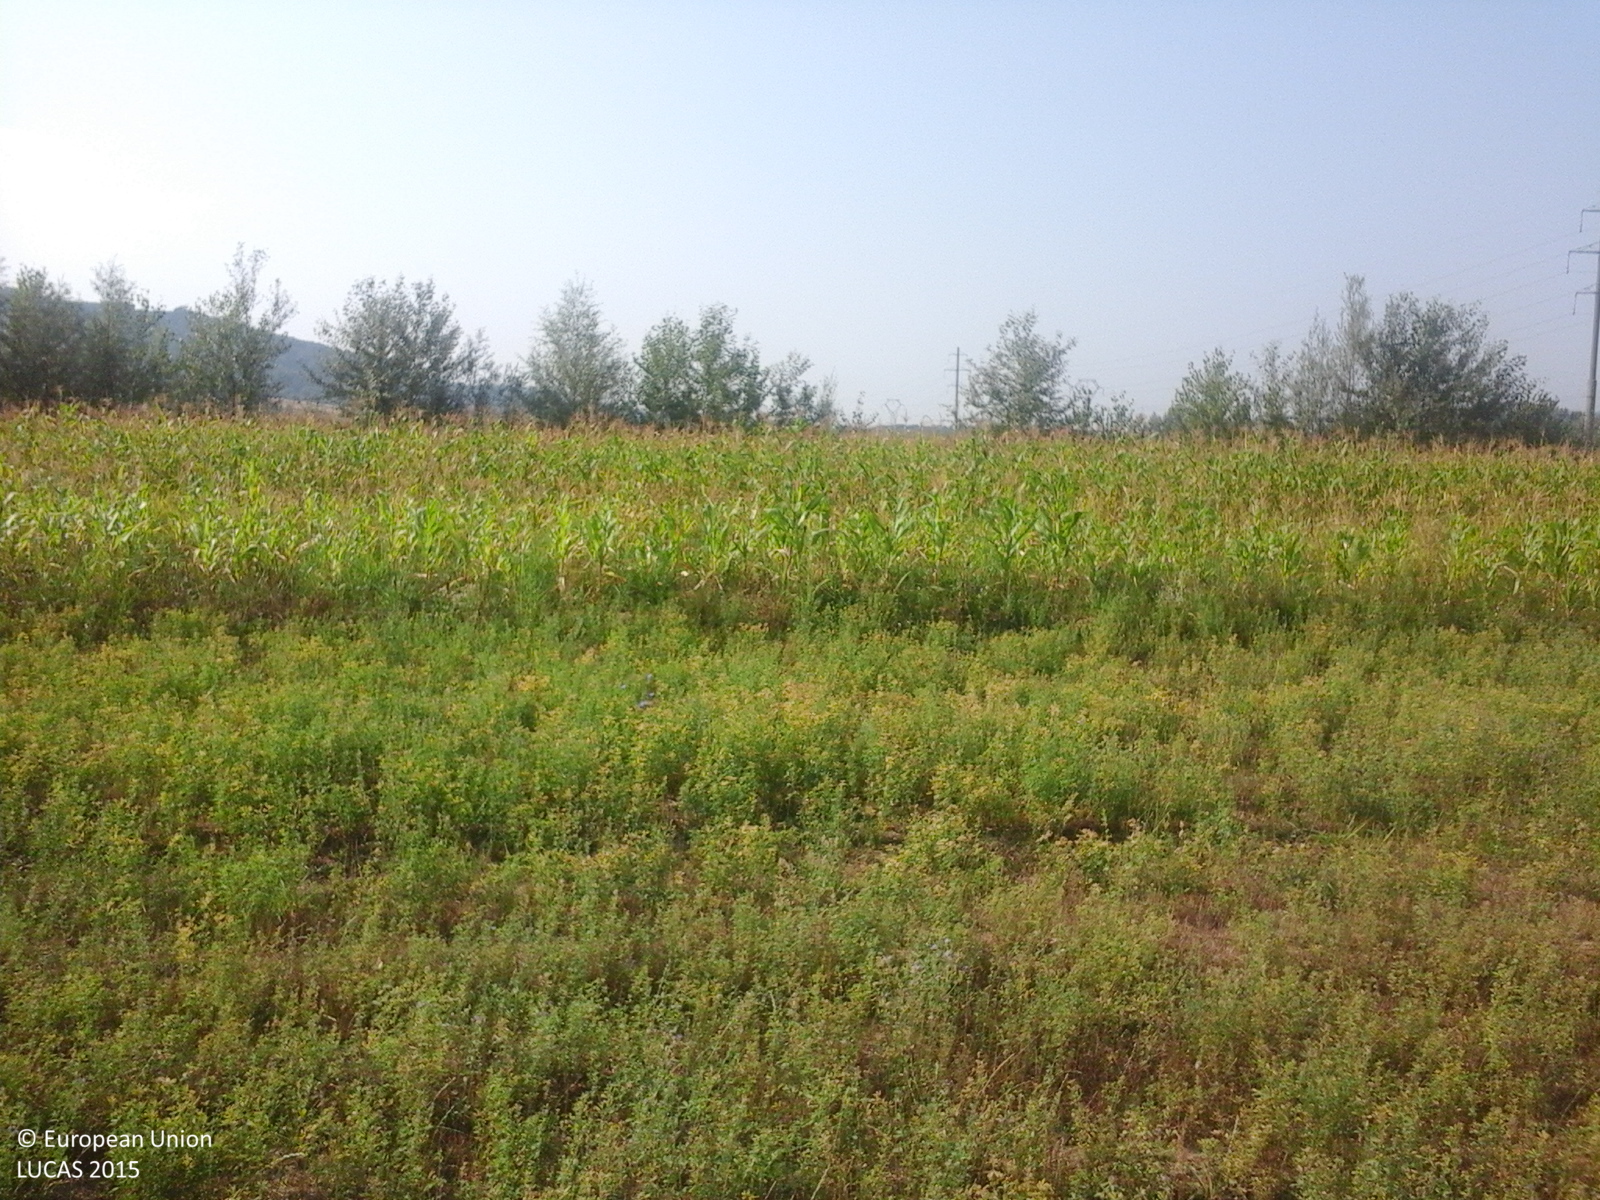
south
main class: Cropland
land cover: Lucerne
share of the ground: > 75 %
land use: Agriculture (excluding fallow land and kitchen gardens)
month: August
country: RO
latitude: 44.8476
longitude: 23.5314
